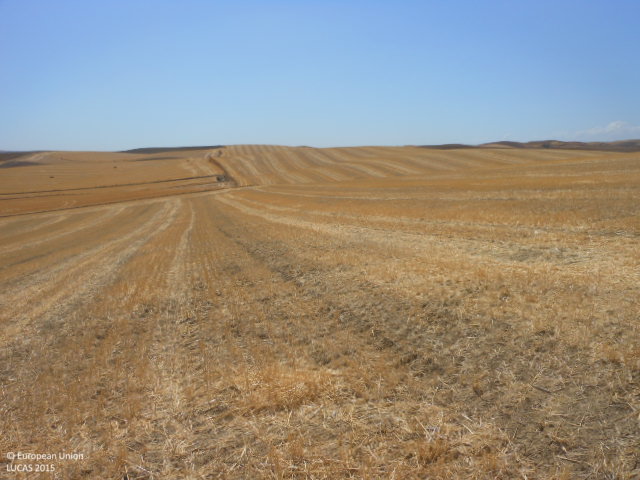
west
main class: Cropland
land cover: Common wheat
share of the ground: < 10 %
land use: Agriculture (excluding fallow land and kitchen gardens)
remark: Harvested field
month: July
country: ES
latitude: 37.4288
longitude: -5.3726
